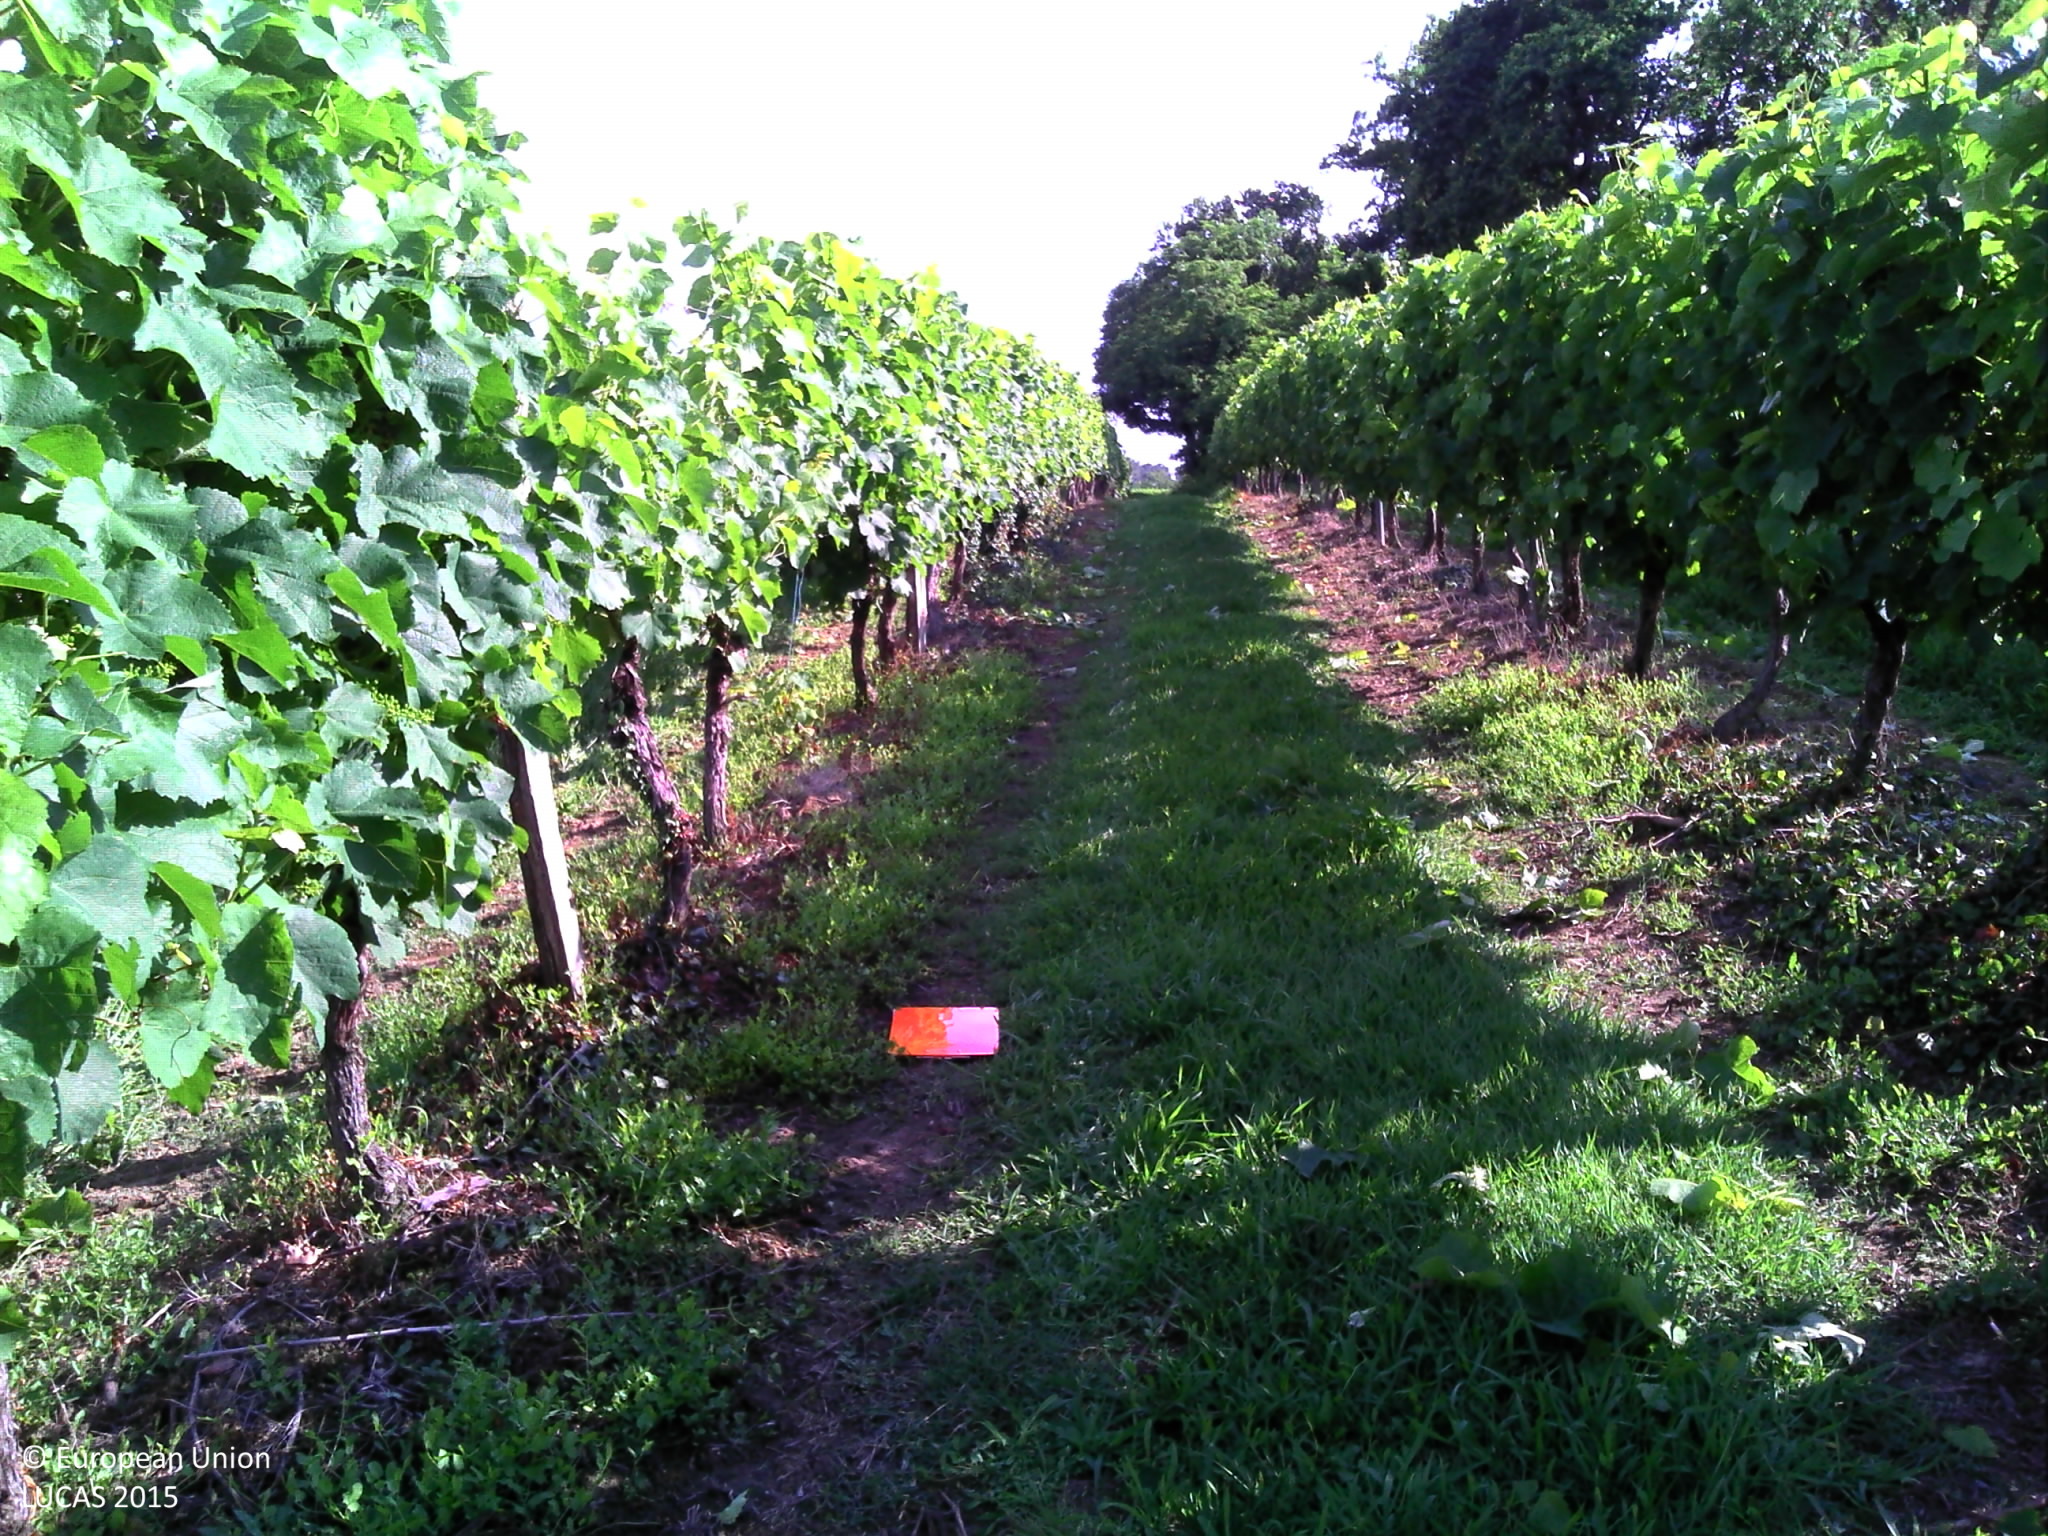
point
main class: Cropland
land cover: Vineyards
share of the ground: 25 - 50 %
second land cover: Grassland without tree/shrub cover
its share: 25 - 50 %
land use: Agriculture (excluding fallow land and kitchen gardens)
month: June
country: FR
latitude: 43.8421
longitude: -0.2459
